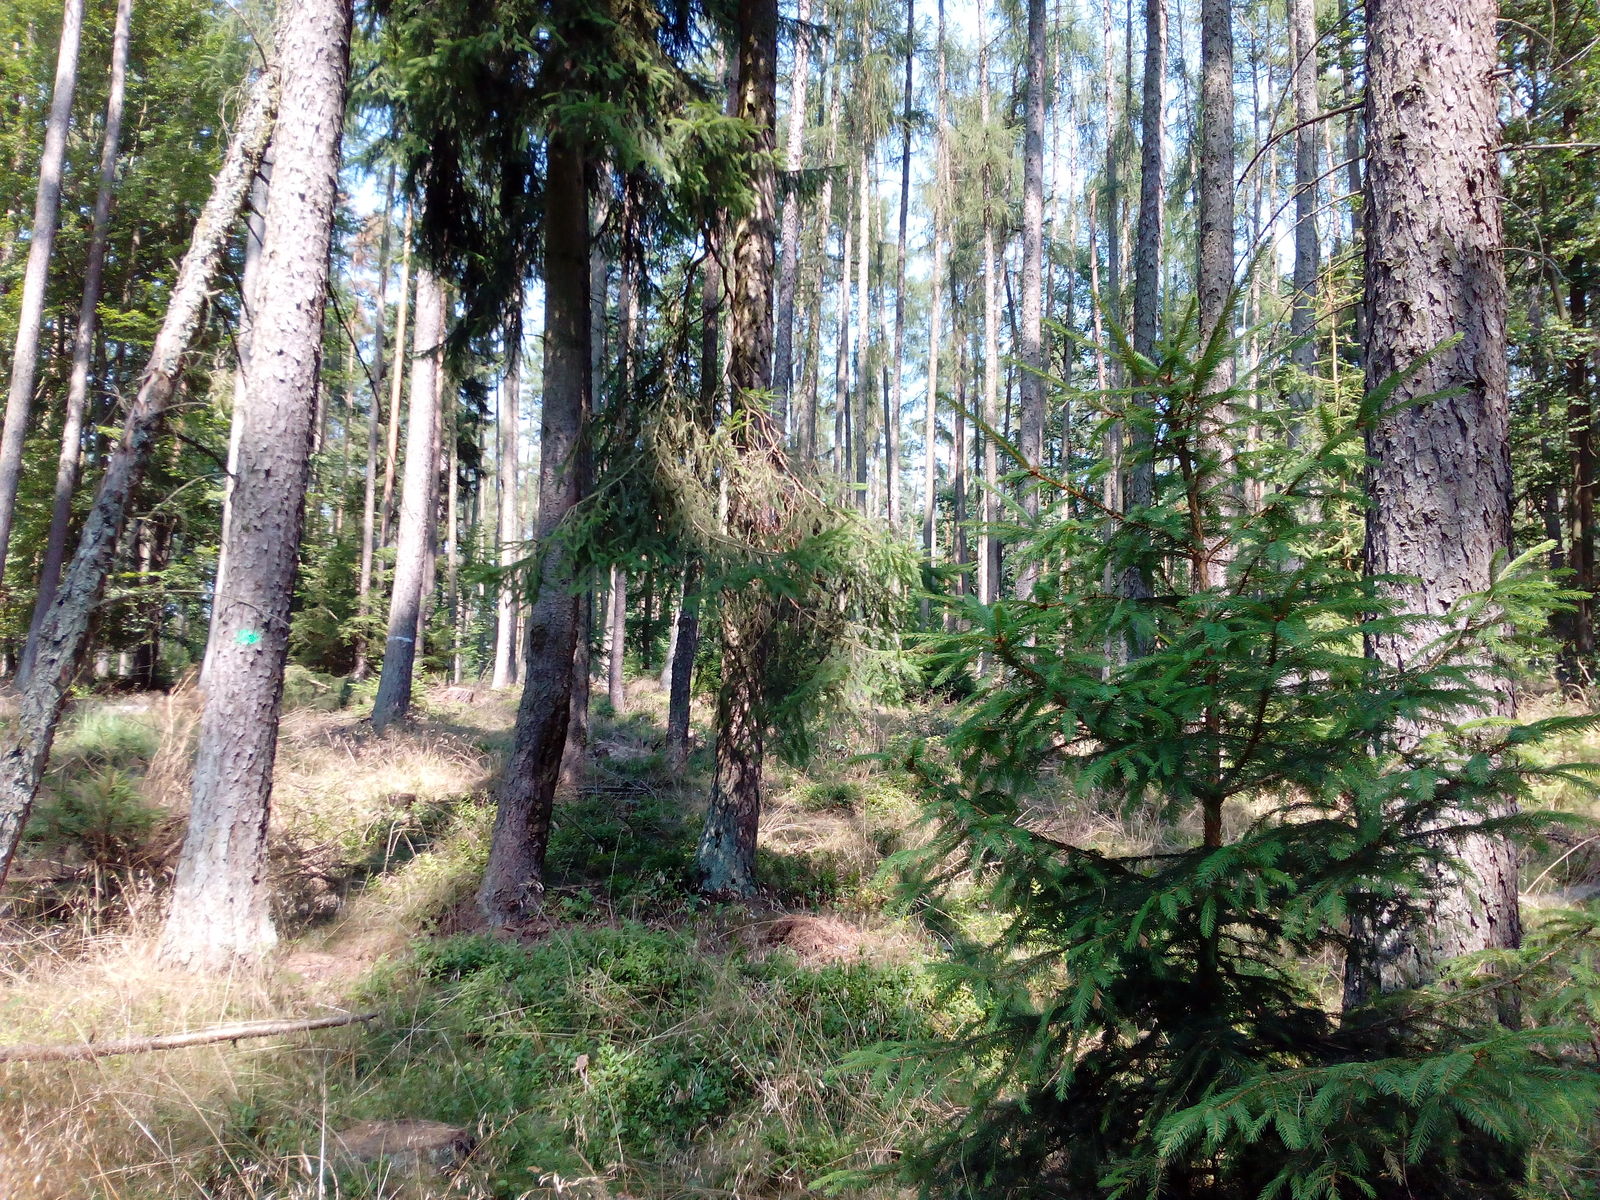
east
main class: Woodland
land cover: Other coniferous woodland
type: hemiboreal forest and nemoral coniferous forest and mixed broadleaved-coniferous forest
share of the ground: > 75 %
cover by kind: coniferous forest trees 85 %, herbaceous plants 10 %, shrubs 5 %
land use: Forestry
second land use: Amenities, museums, leisure
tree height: > 5 m
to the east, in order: Other coniferous woodland; Other mixed woodland; Tracks; Other mixed woodland; Other coniferous woodland
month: August
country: DE
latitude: 50.6514
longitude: 10.2686
